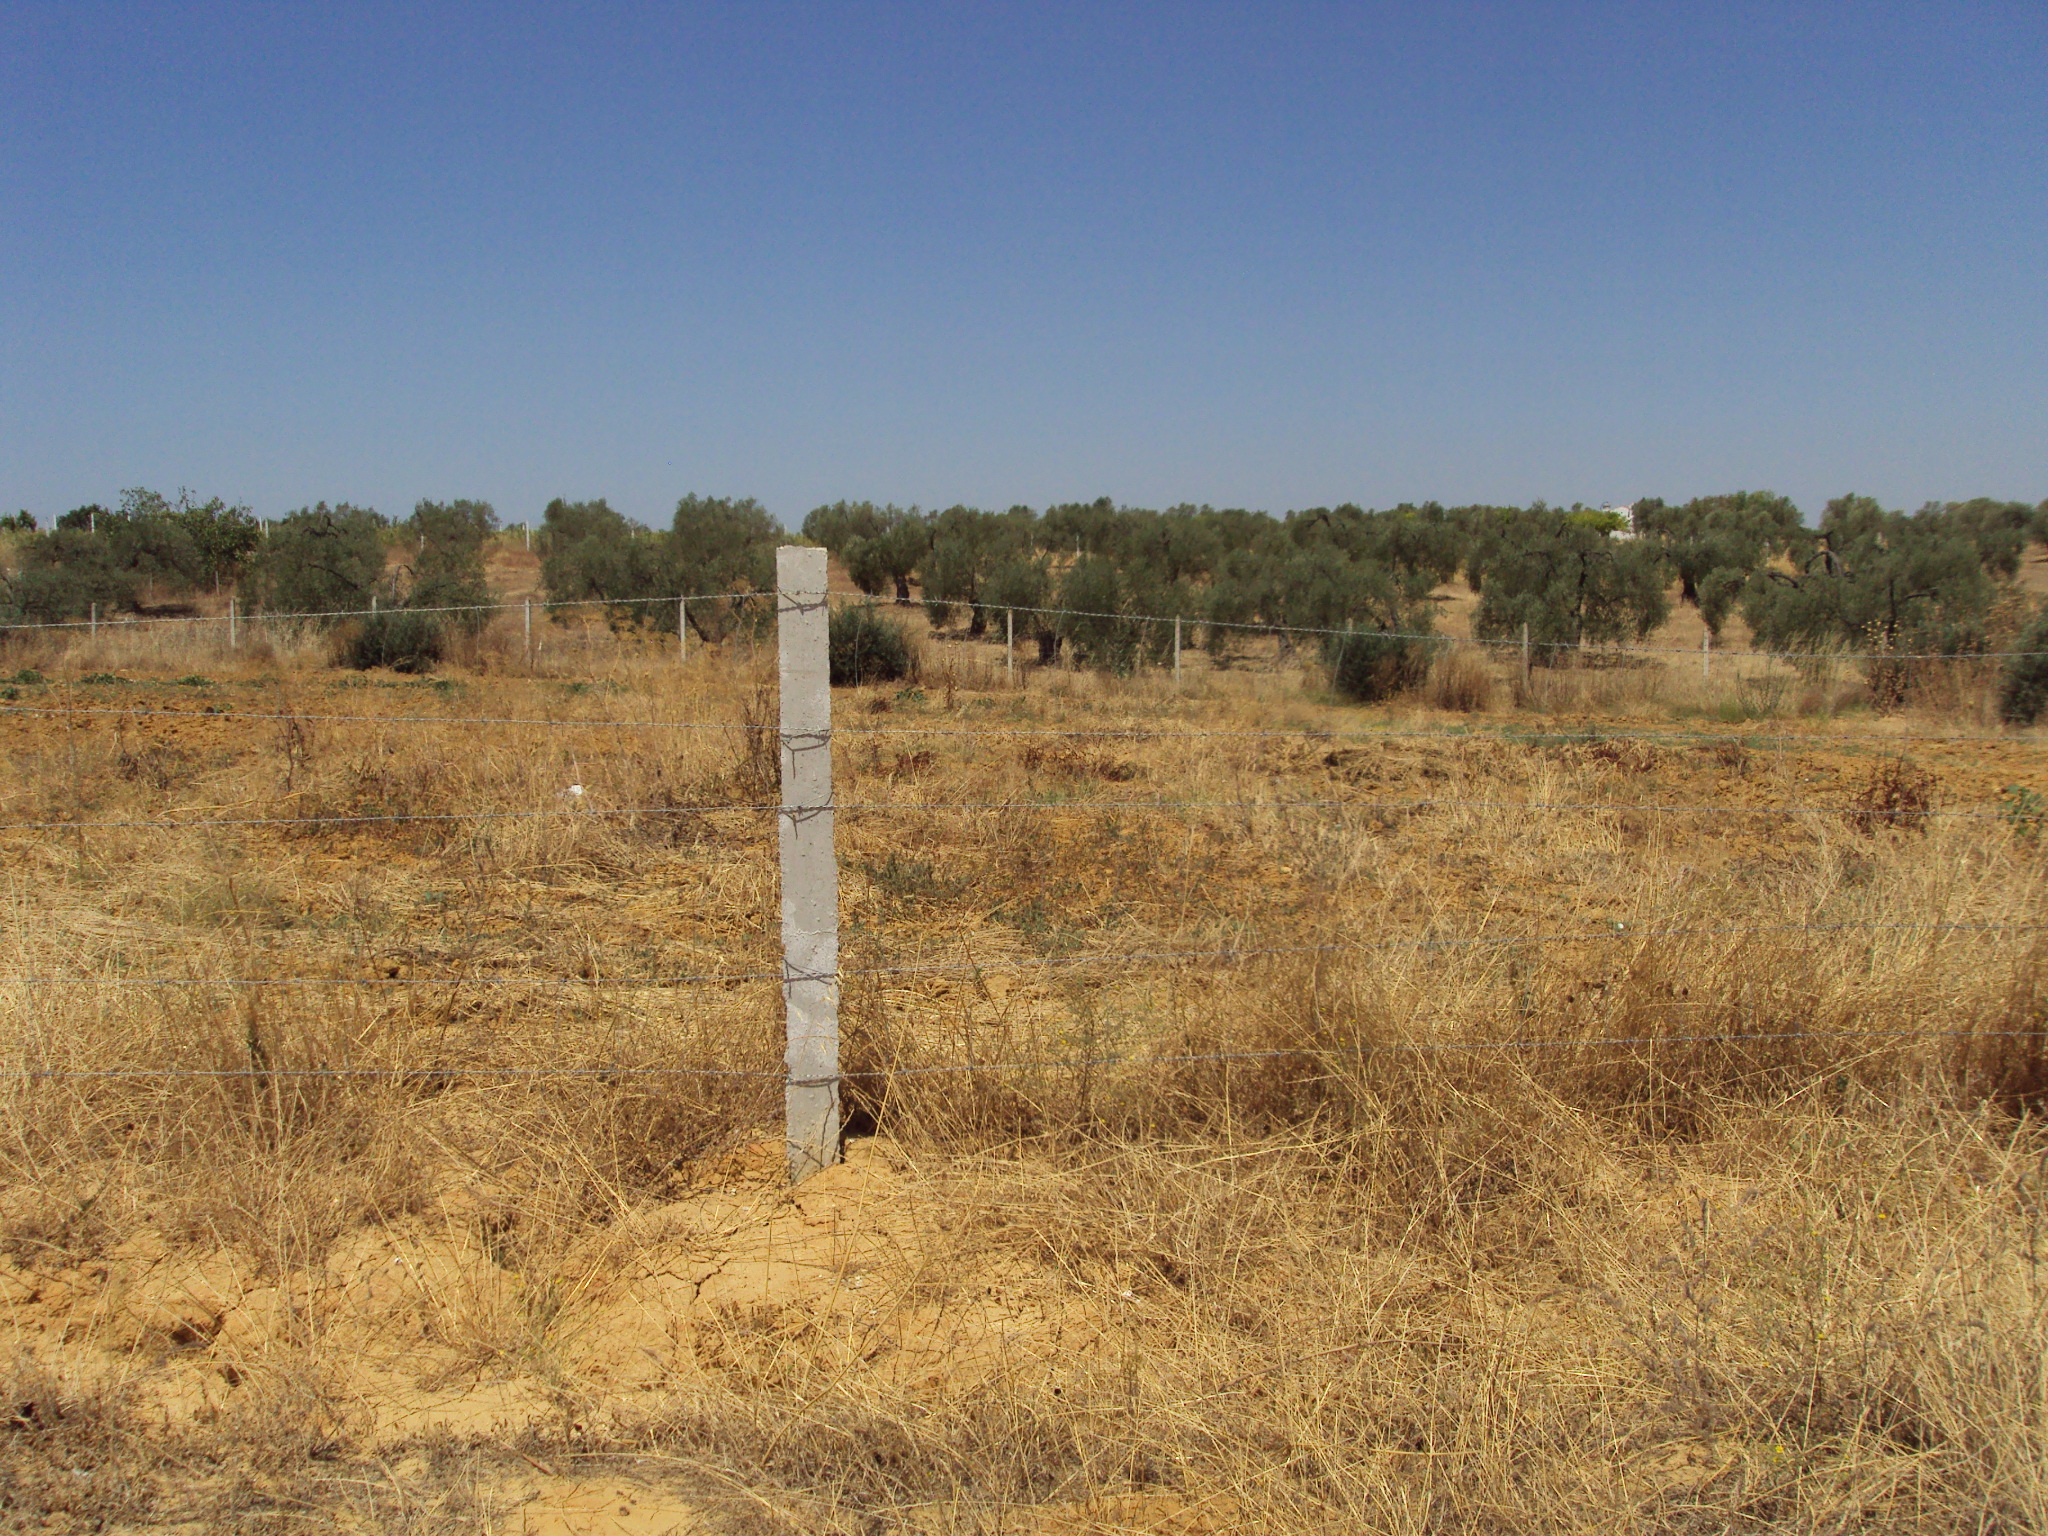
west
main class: Cropland
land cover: Other fresh vegetables
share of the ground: 10 - 25 %
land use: Agriculture (excluding fallow land and kitchen gardens)
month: July
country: ES
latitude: 37.2471
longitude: -6.5463
